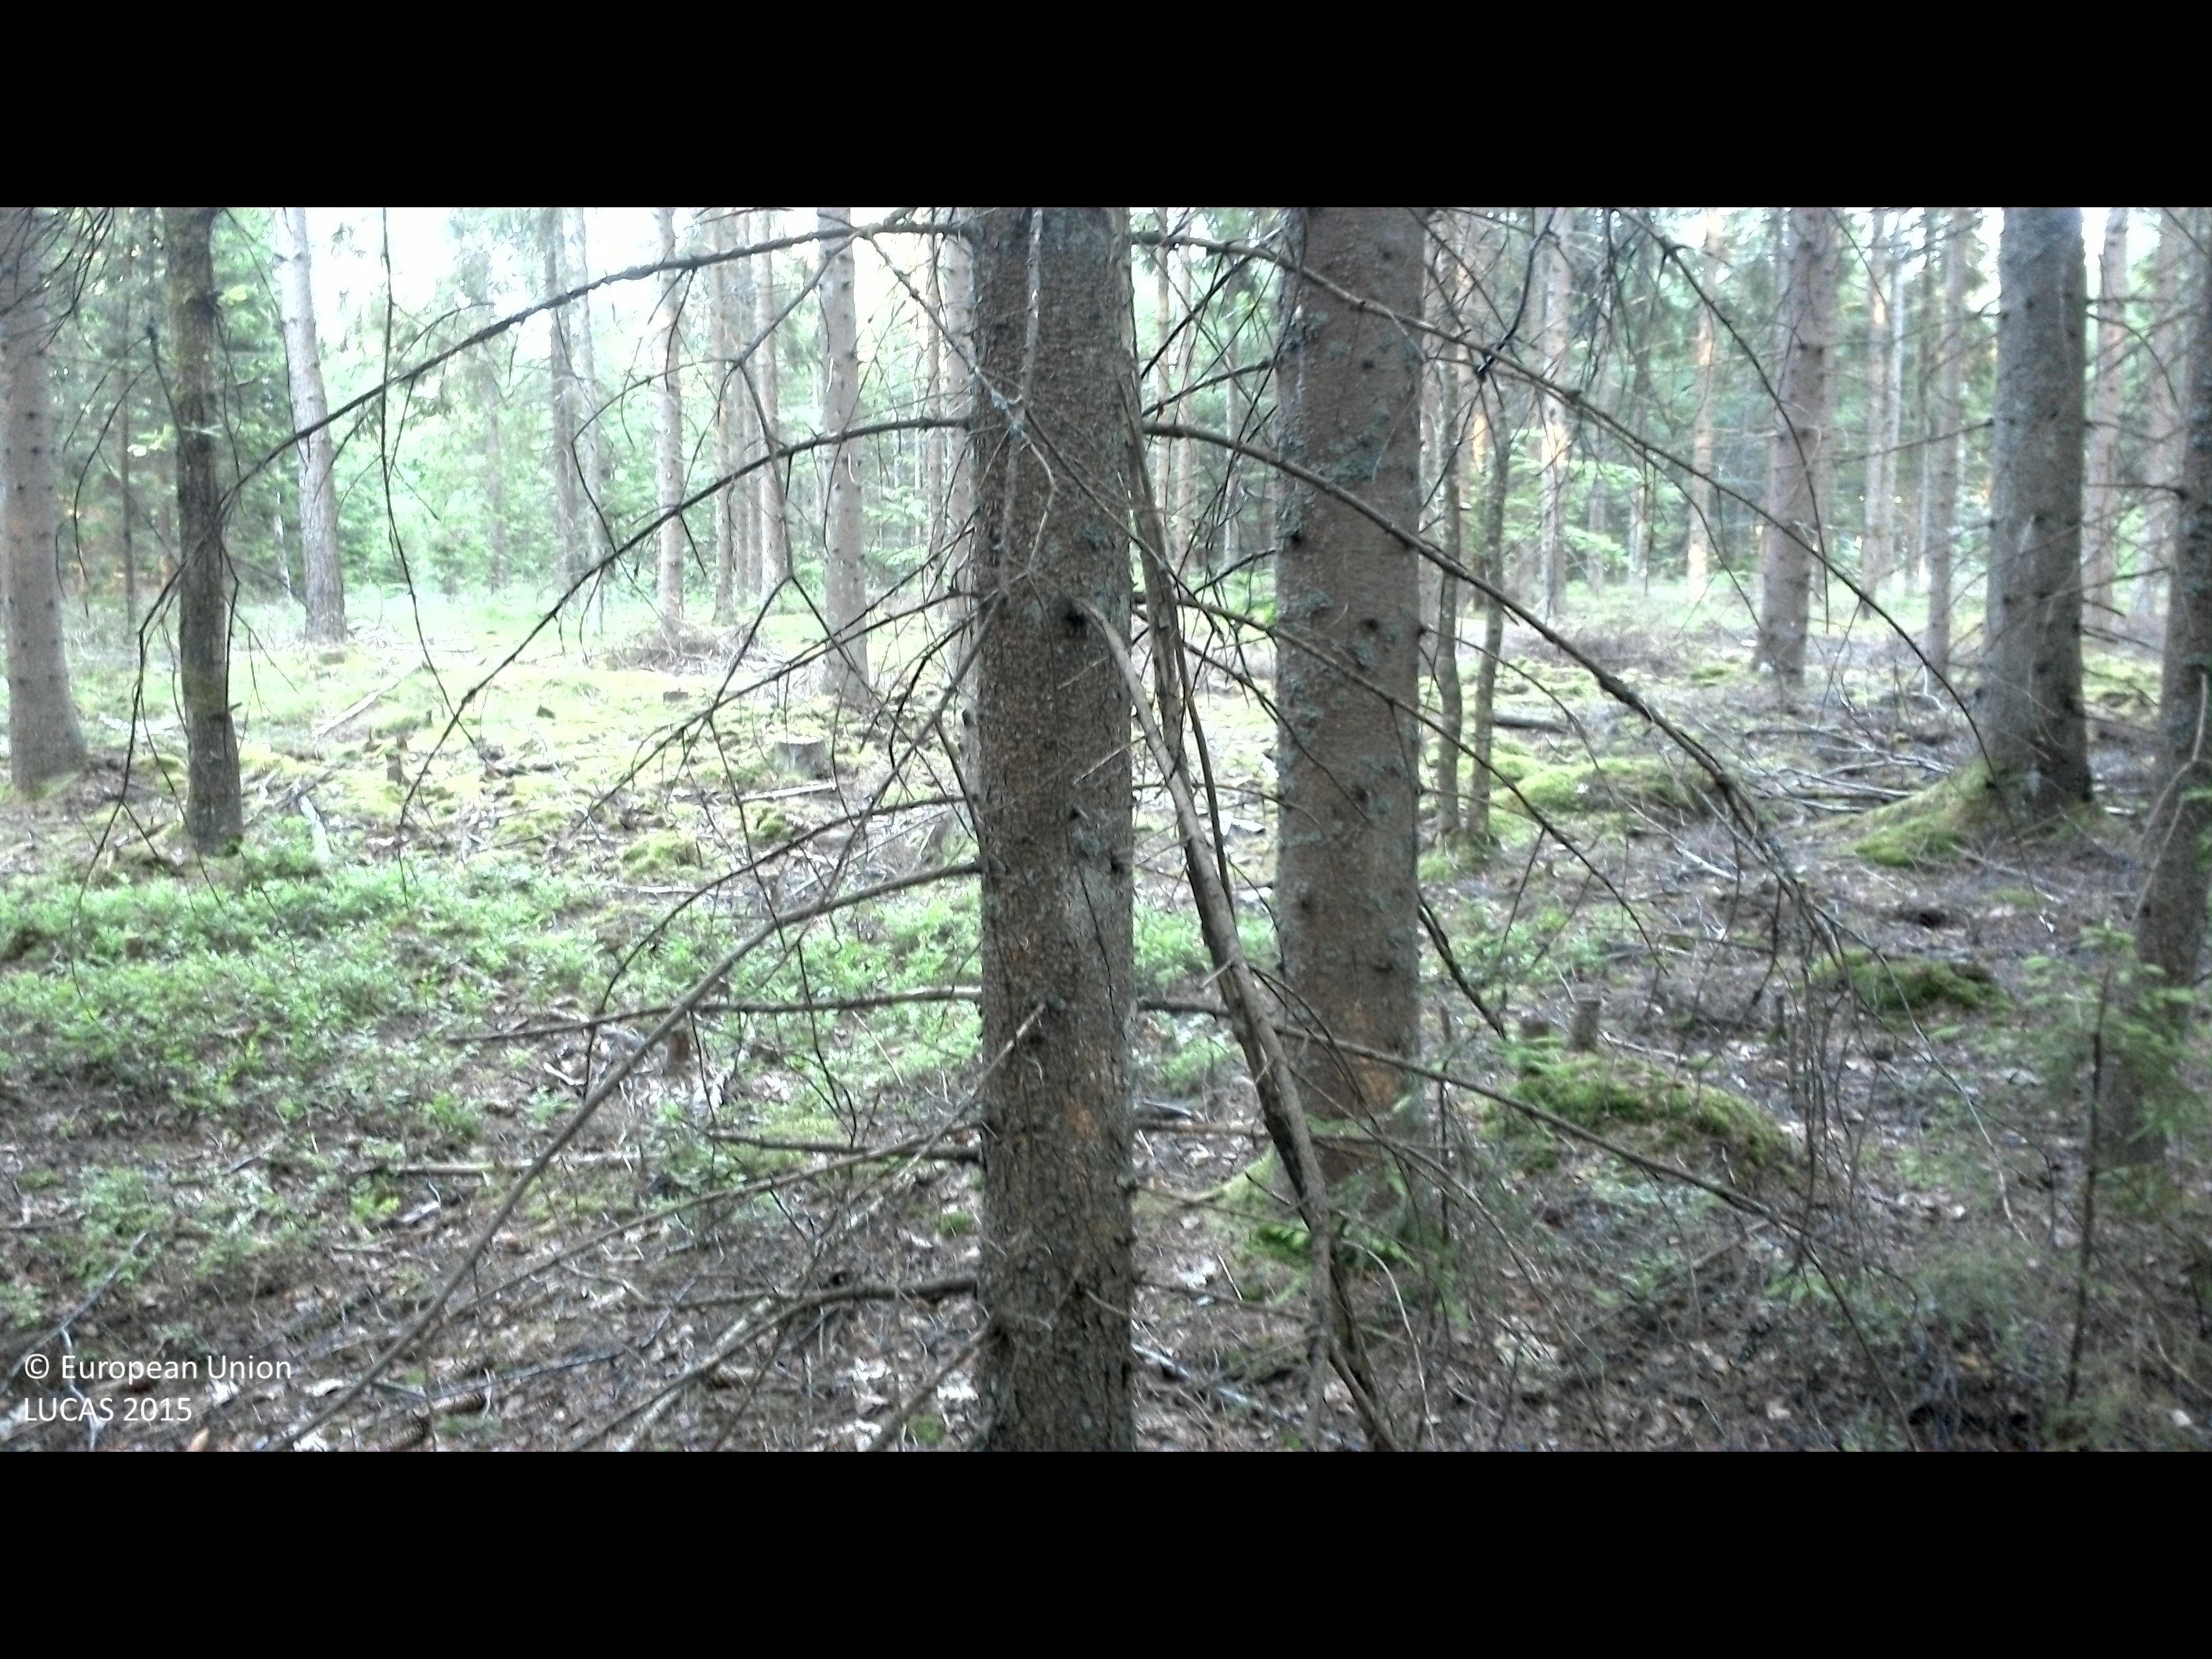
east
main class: Woodland
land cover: Spruce dominated coniferous woodland
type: boreal forest
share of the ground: > 75 %
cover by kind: coniferous forest trees 85 %, broadleaved forest trees 5 %, shrubs 5 %, lichens and mosses 5 %
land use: Forestry
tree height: > 5 m
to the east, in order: Spruce dominated coniferous woodland; Tracks; Other coniferous woodland; Dry stone walls; Other coniferous woodland; Broadleaved woodland; Tracks; Abandoned hedges; Paved roads, cycling and walking lanes; Grass margins; Broadleaved woodland; Spruce dominated coniferous woodland
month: July
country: SE
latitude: 56.4849
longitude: 15.0485
